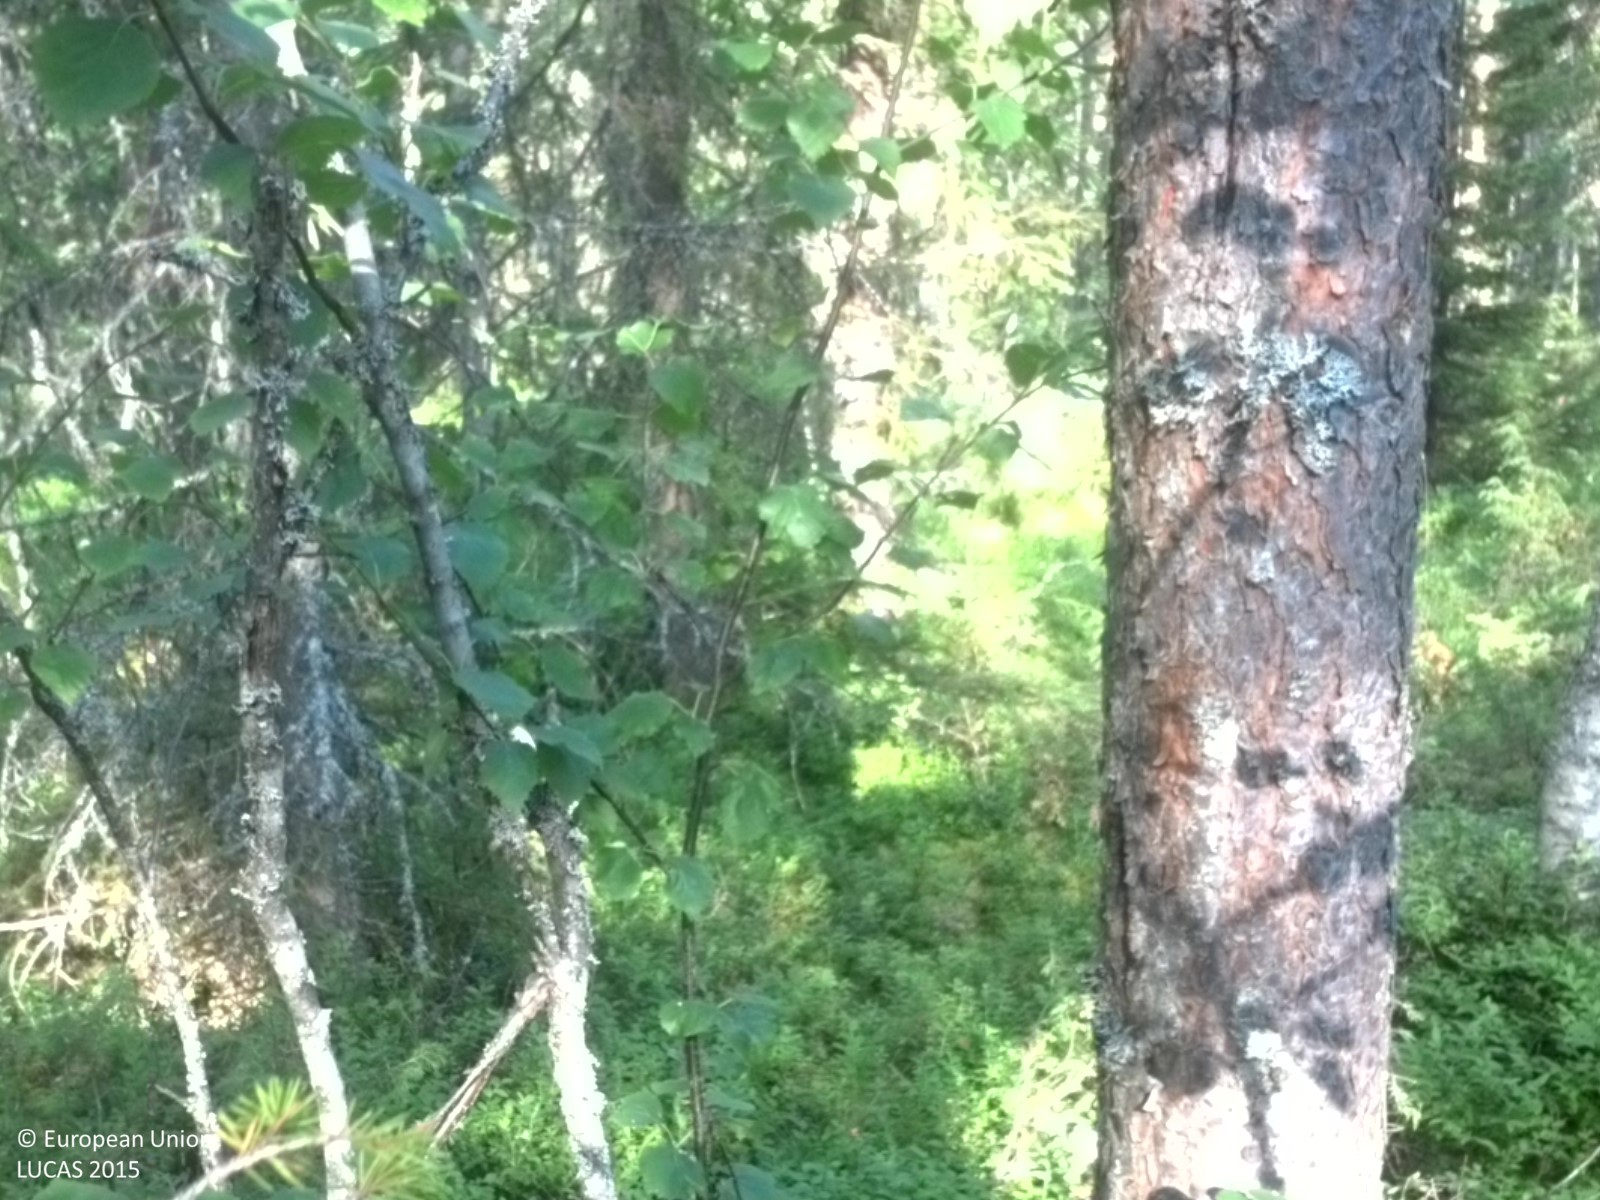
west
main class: Woodland
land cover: Other mixed woodland
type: boreal forest
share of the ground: 50 - 75 %
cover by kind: coniferous forest trees 40 %, herbaceous plants 30 %, broadleaved forest trees 20 %, shrubs 10 %
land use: Forestry
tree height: > 5 m
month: July
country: SE
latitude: 63.6868
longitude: 19.9088
